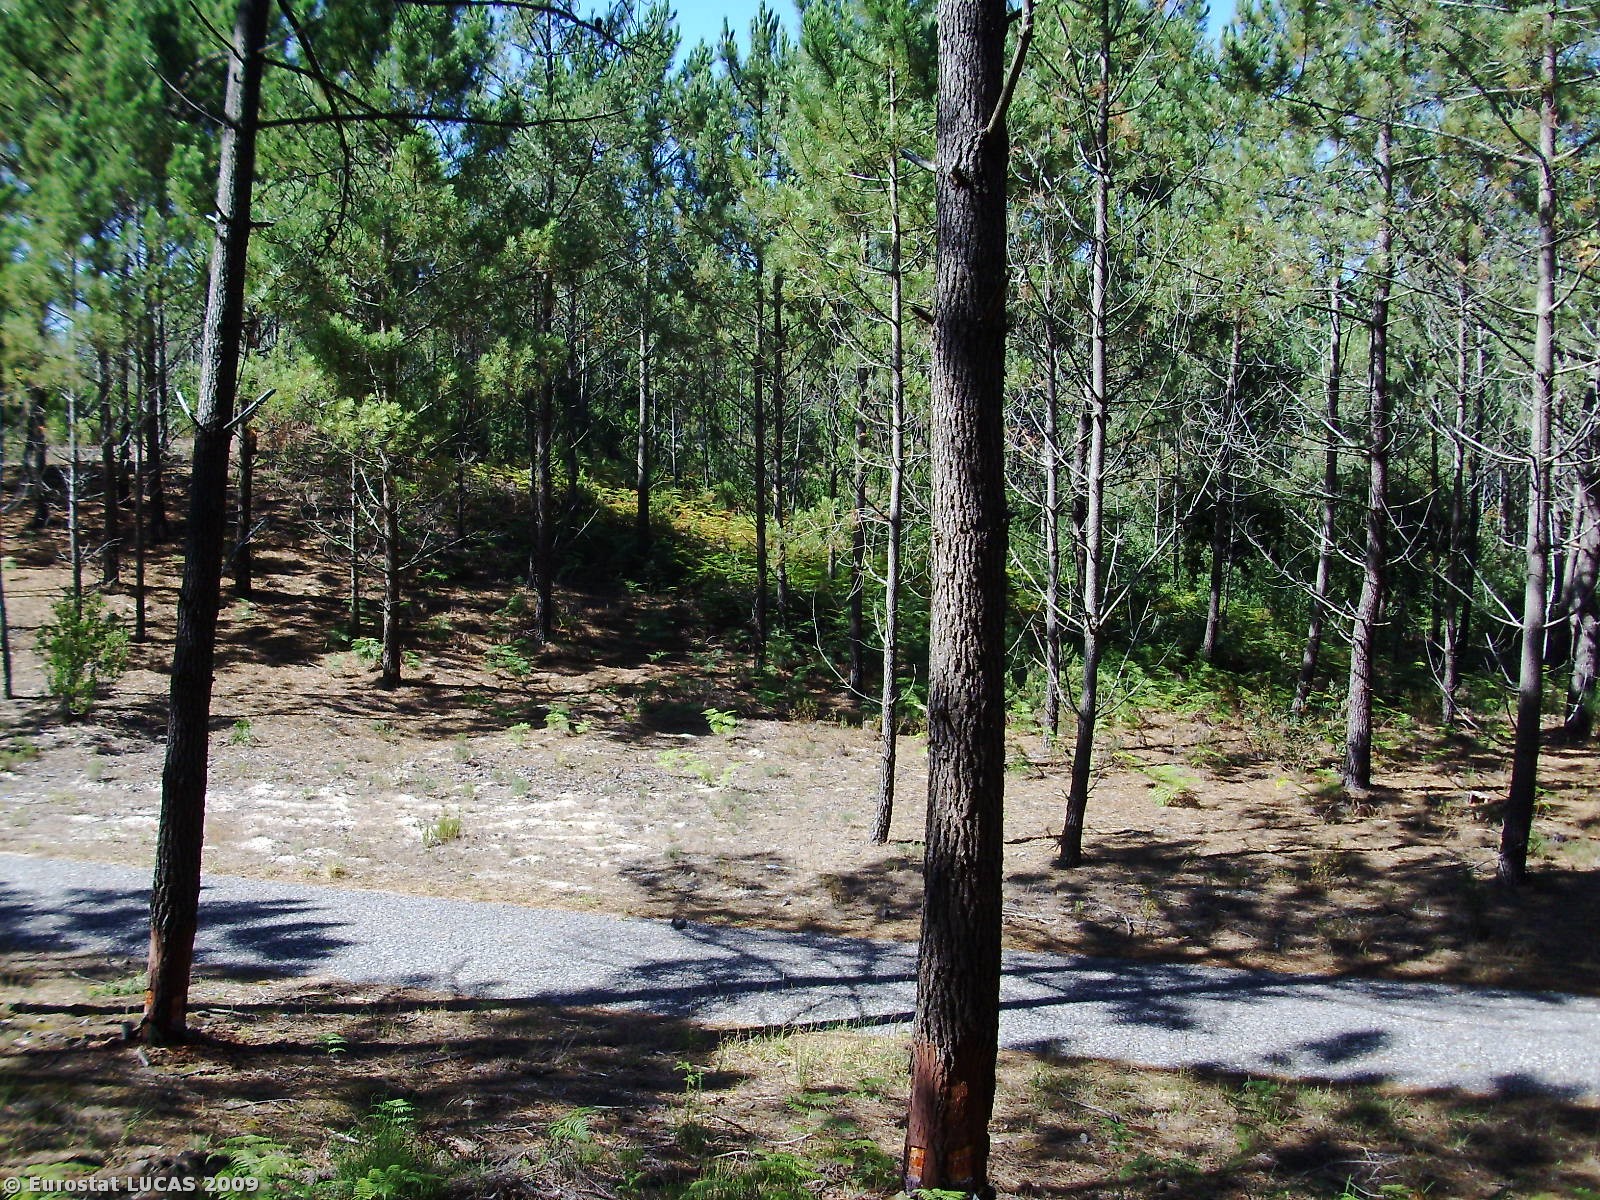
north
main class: Woodland
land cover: Coniferous woodland
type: coniferous forest of the mediterranean region
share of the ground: > 75 %
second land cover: Shrubland with sparse tree cover
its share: 10 - 25 %
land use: Forestry
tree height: > 5 m
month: July
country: PT
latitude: 39.7244
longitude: -9.0027
